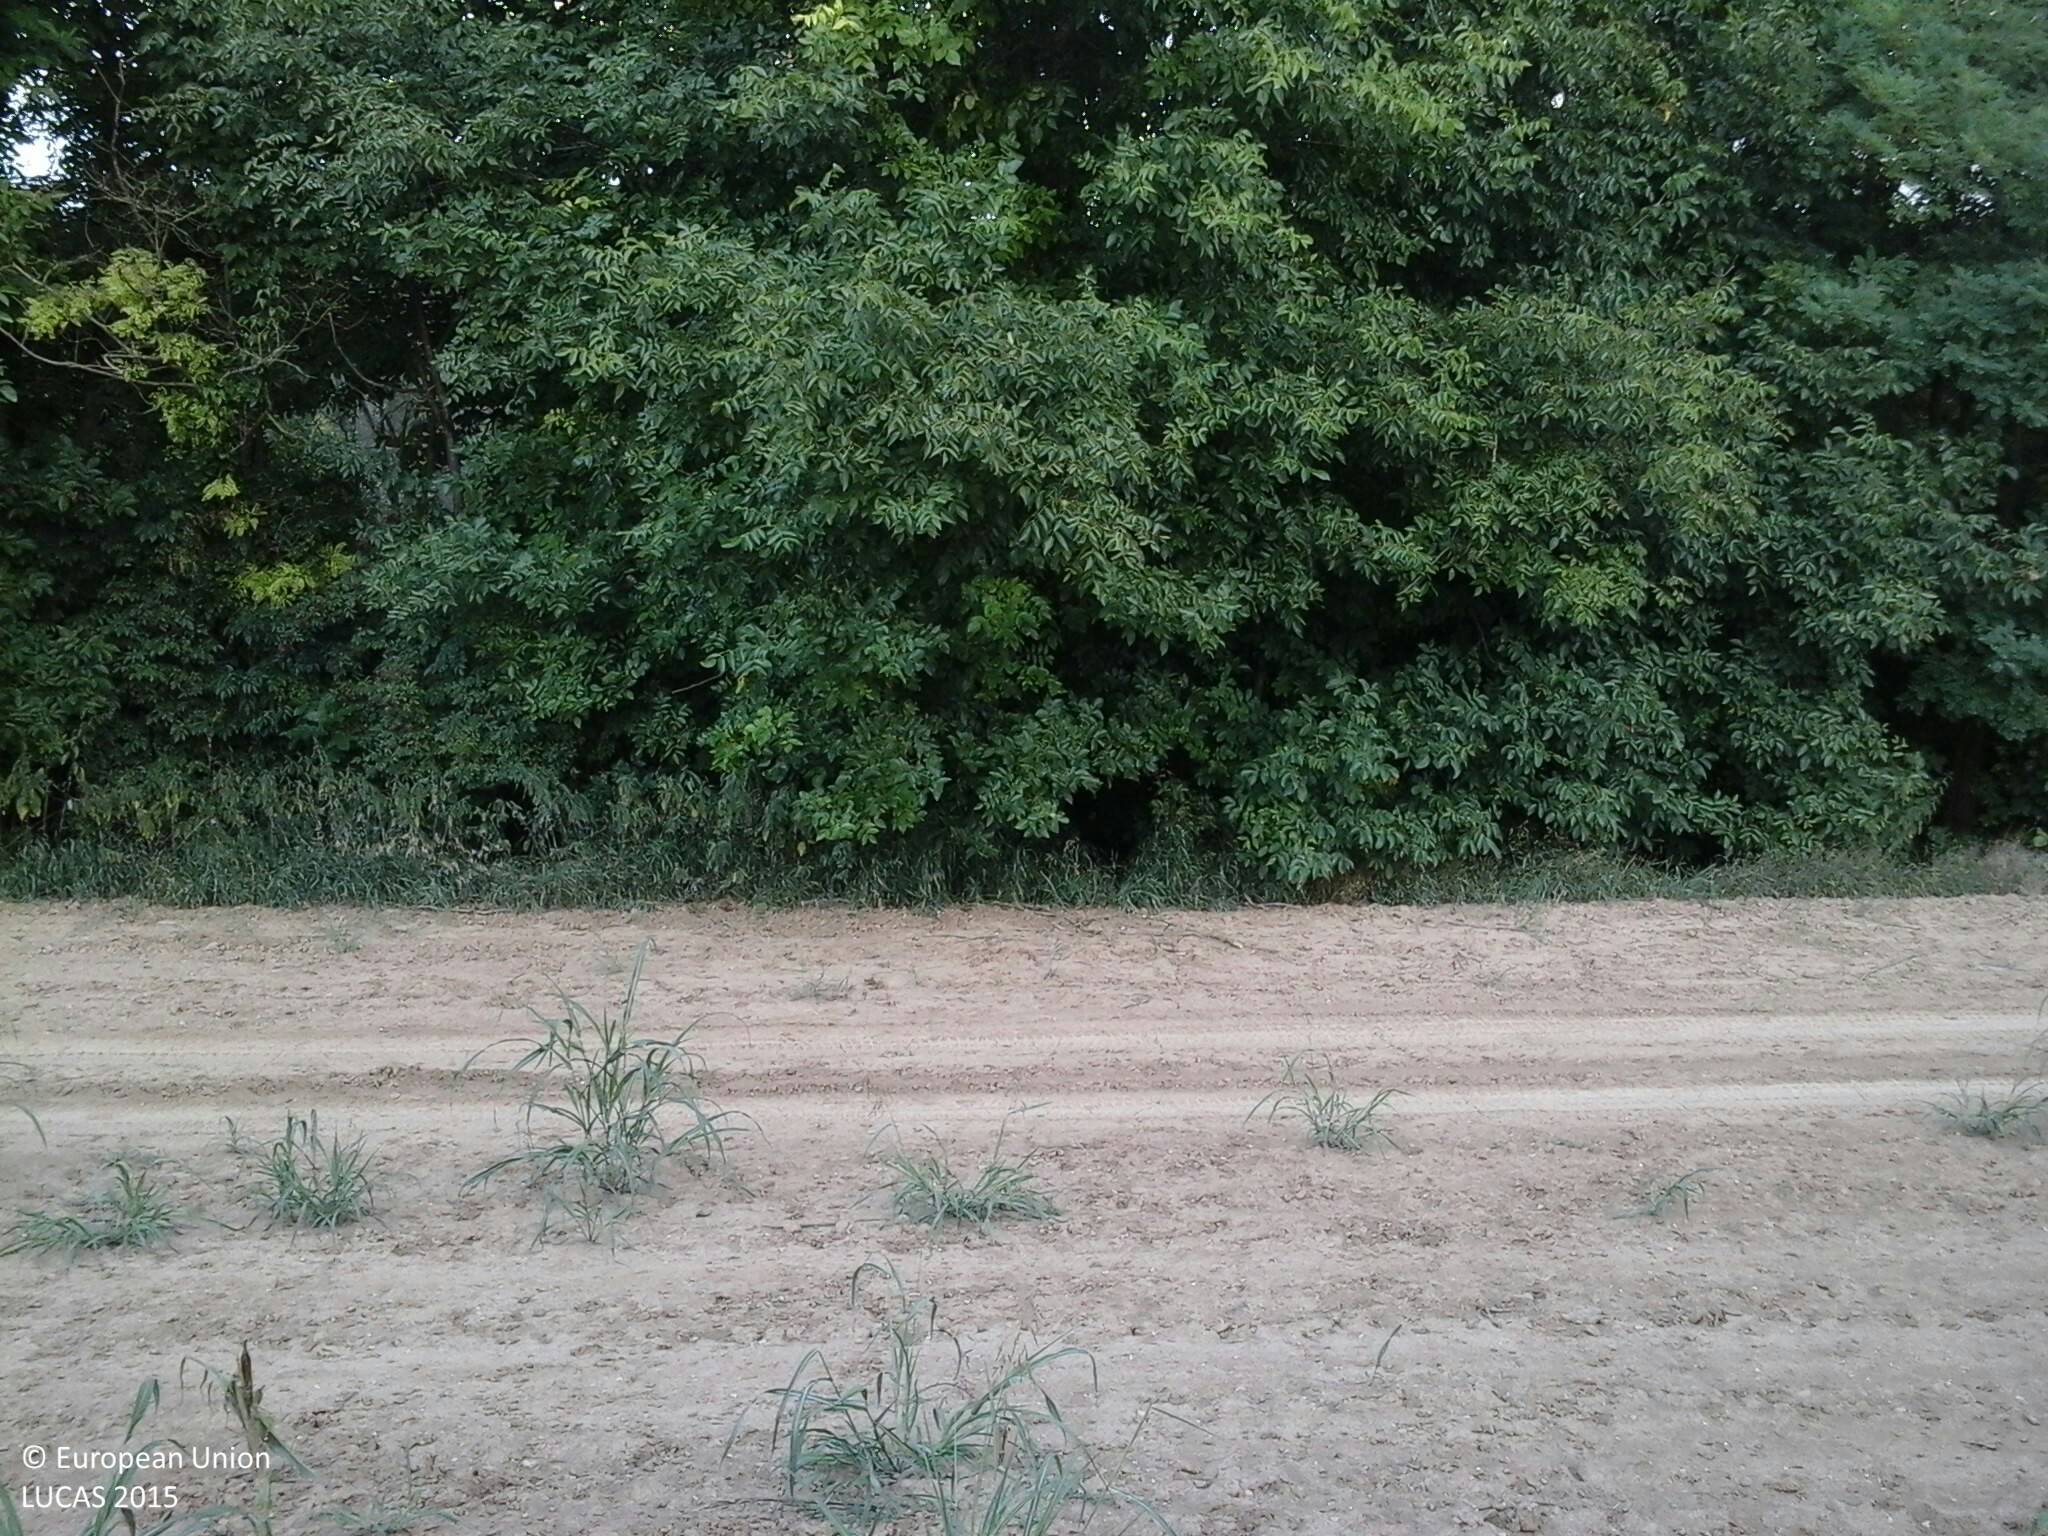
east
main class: Cropland
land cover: Maize
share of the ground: > 75 %
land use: Agriculture (excluding fallow land and kitchen gardens)
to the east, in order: Maize; Other bare soil; Tracks; Other bare soil; Broadleaved woodland; Grassland without tree/shrub cover; Broadleaved woodland
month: August
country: HU
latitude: 45.9734
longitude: 18.3059
